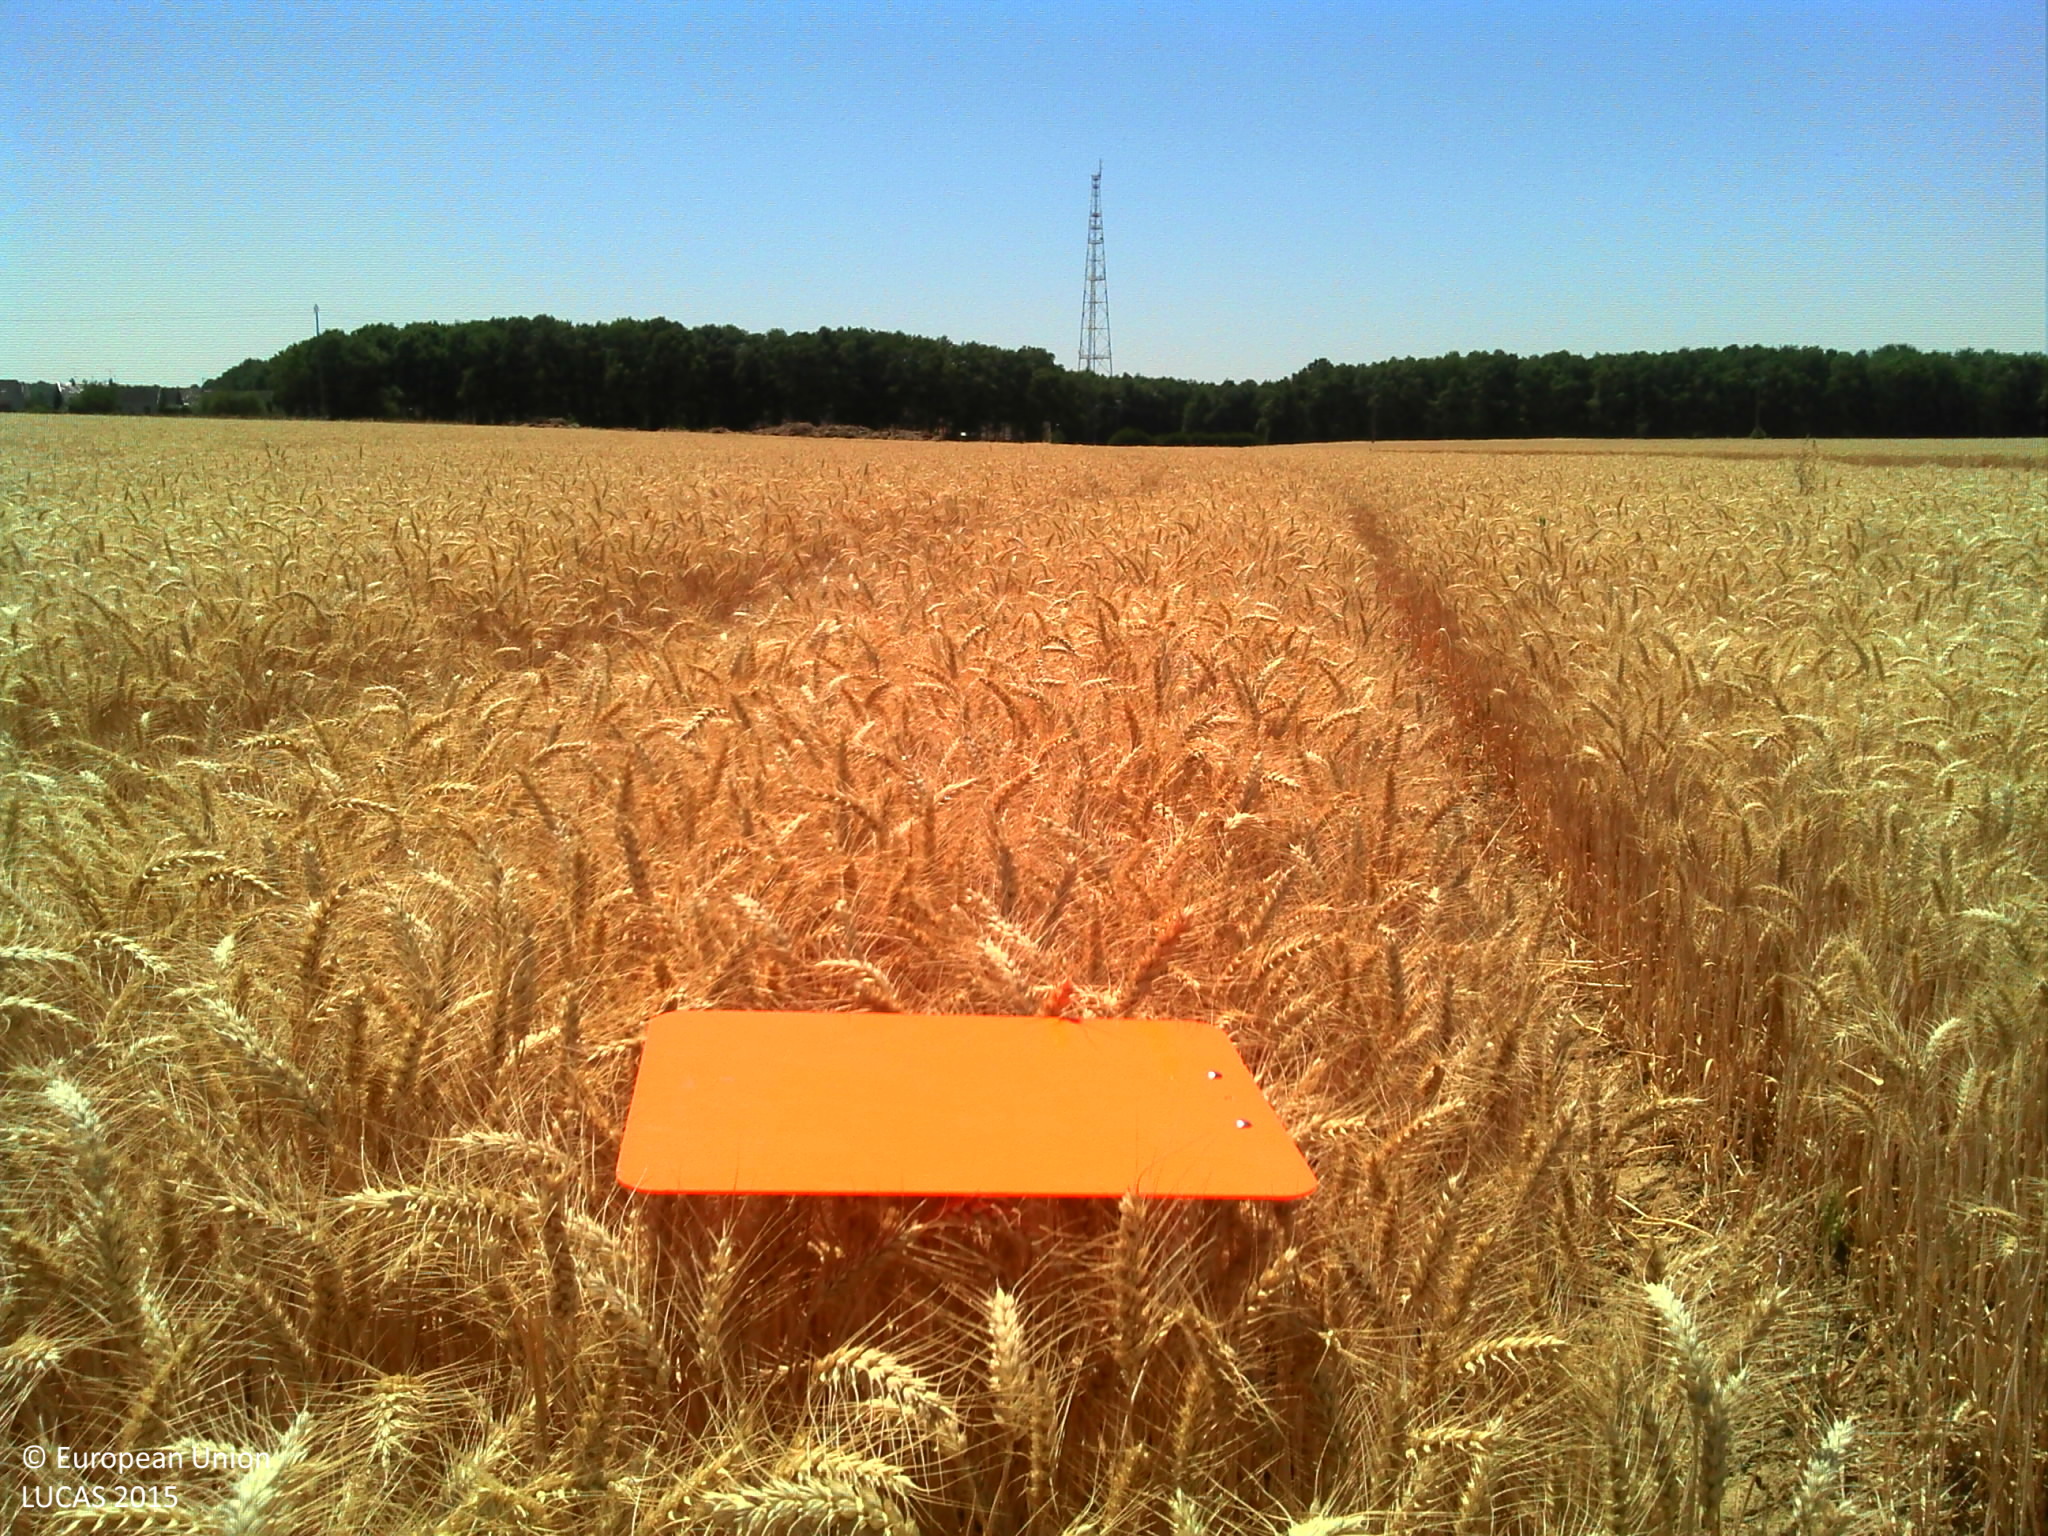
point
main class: Cropland
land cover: Common wheat
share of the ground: > 75 %
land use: Agriculture (excluding fallow land and kitchen gardens)
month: July
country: FR
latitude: 48.0423
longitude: 1.3044
